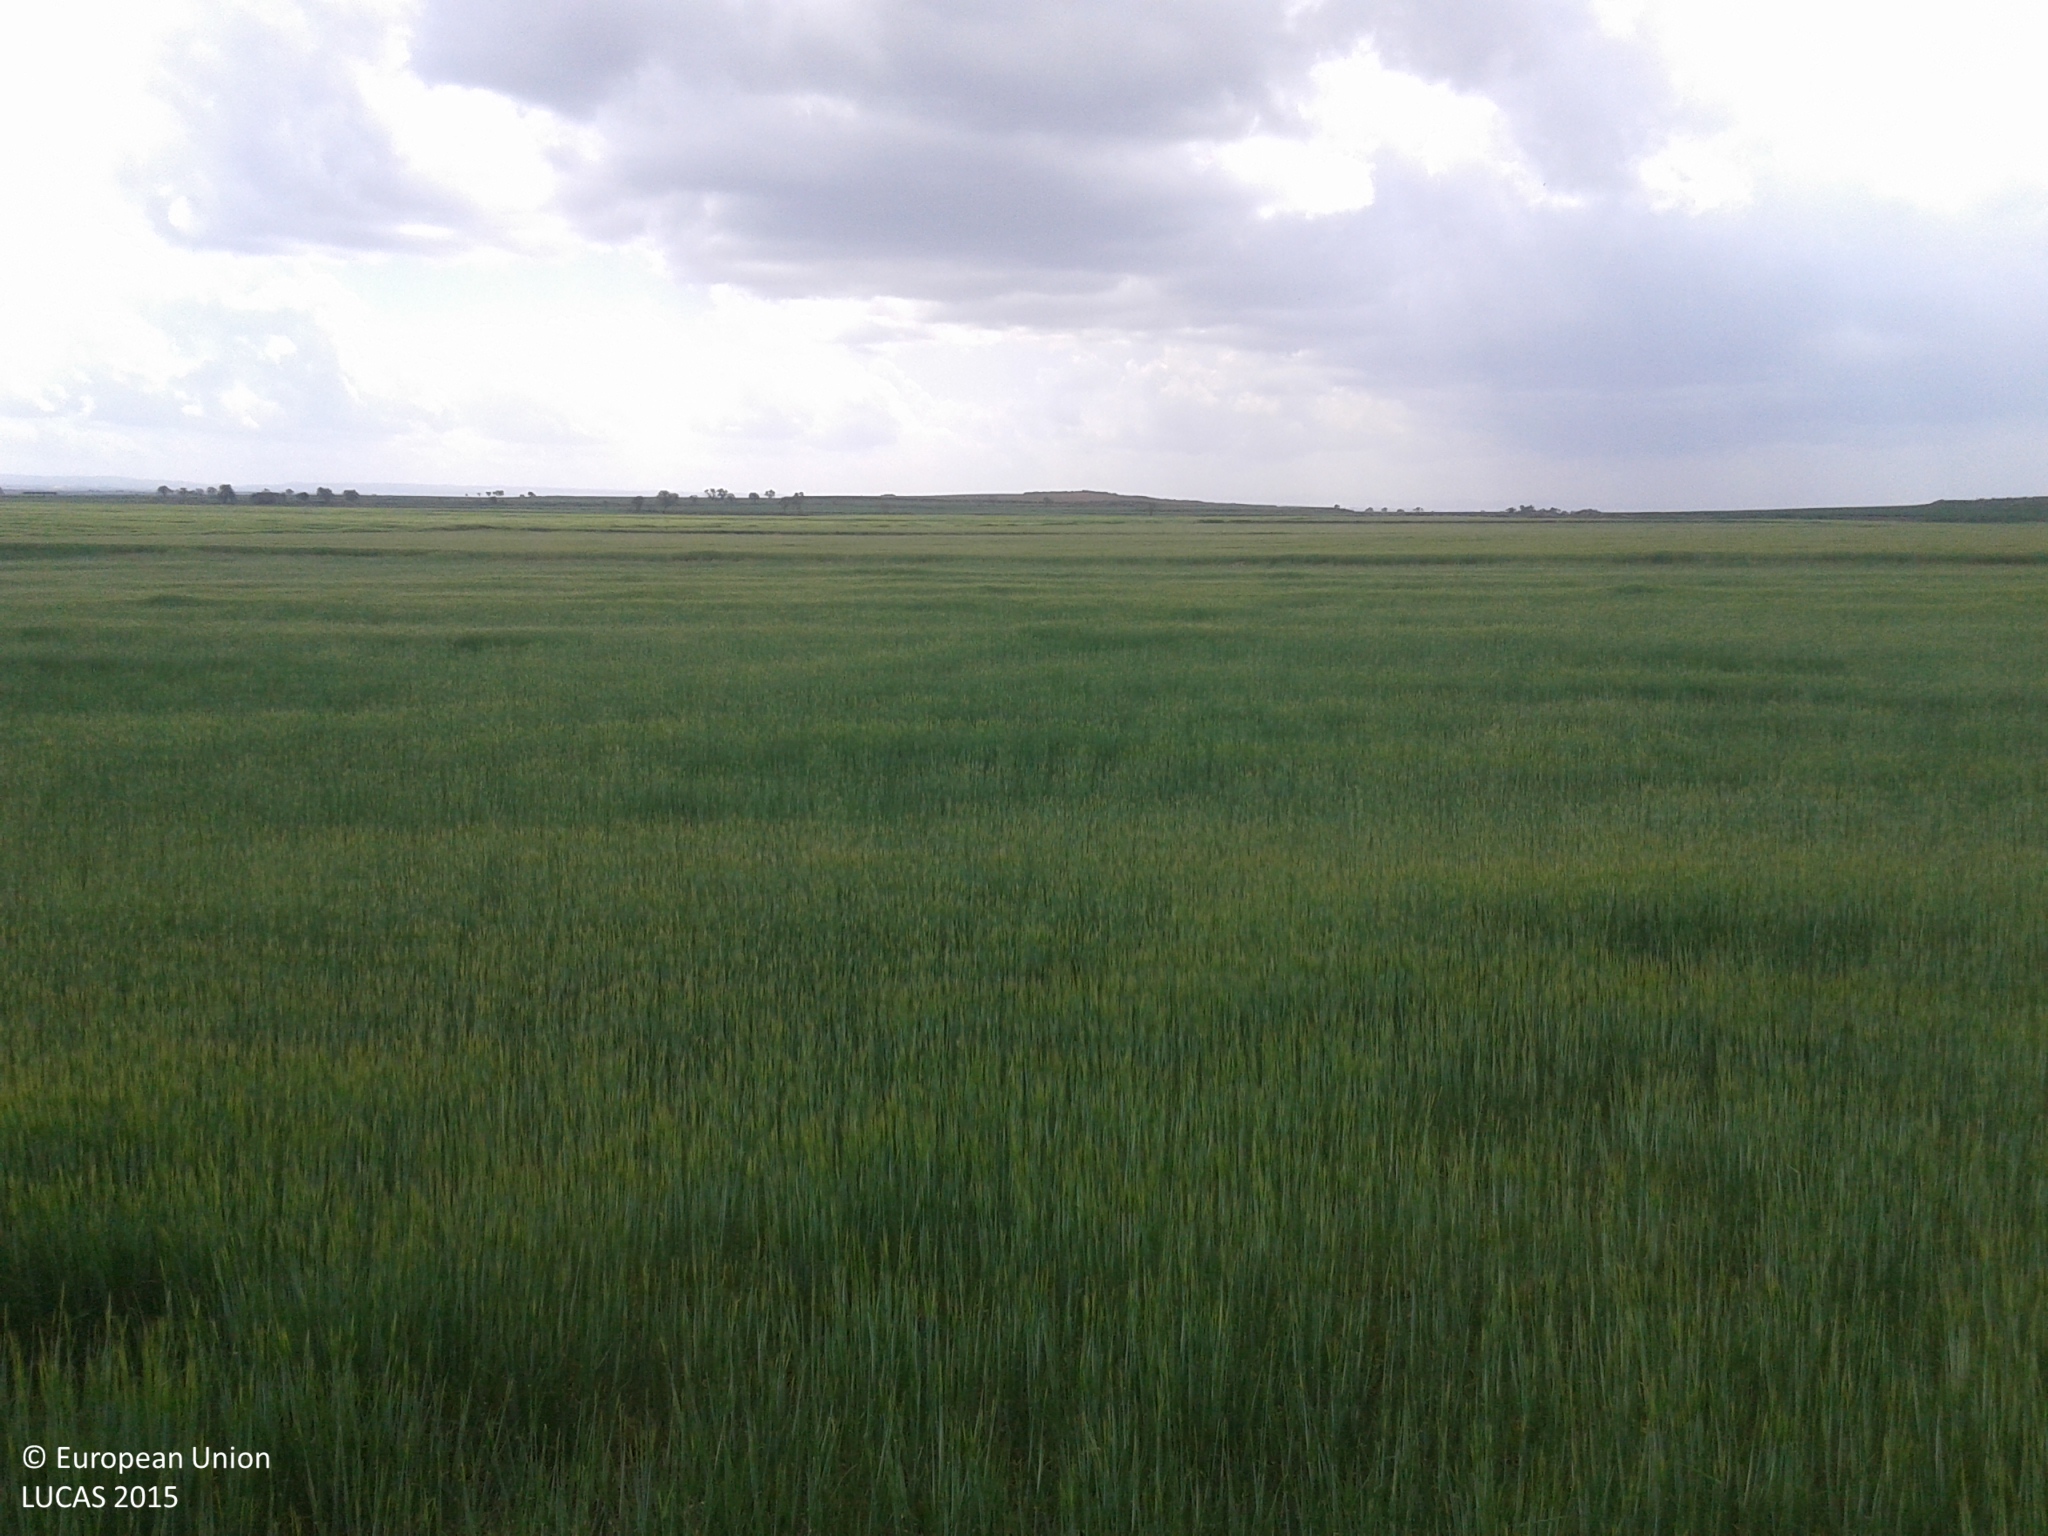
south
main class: Cropland
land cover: Barley
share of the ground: > 75 %
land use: Agriculture (excluding fallow land and kitchen gardens)
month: April
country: ES
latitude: 41.7394
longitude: 1.1514
